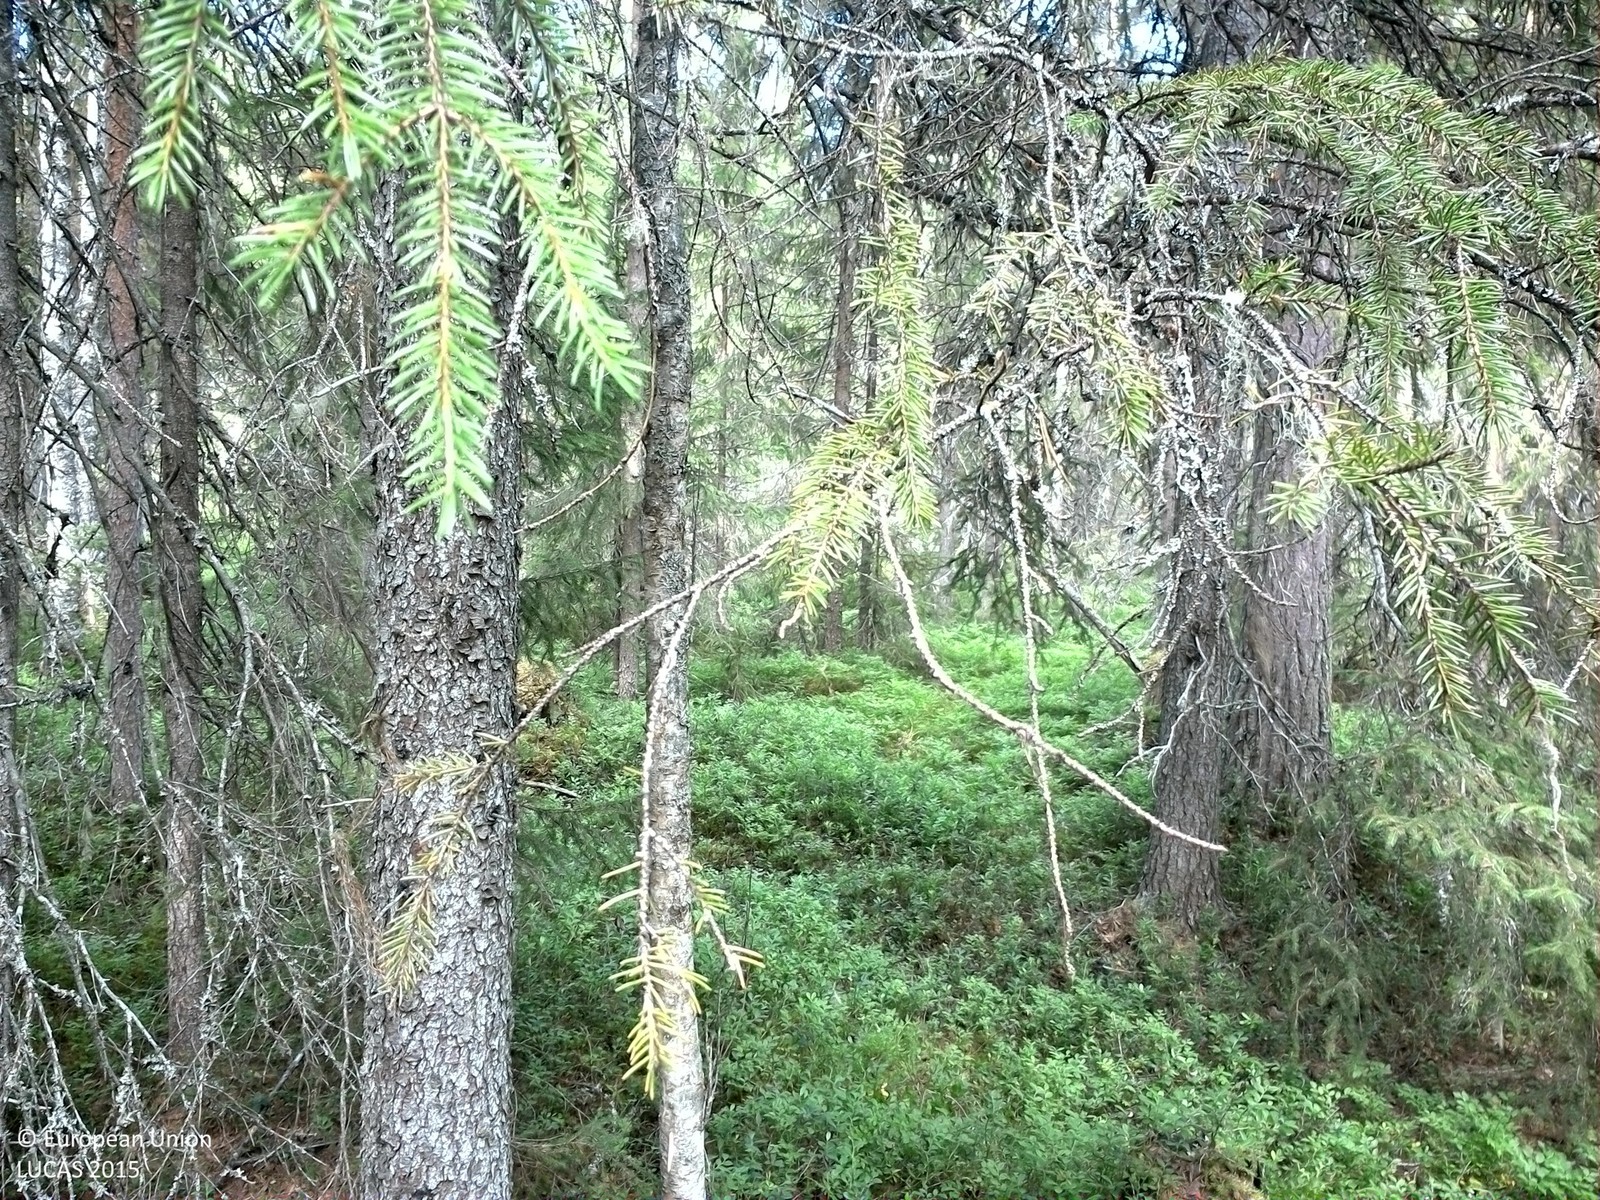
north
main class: Woodland
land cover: Spruce dominated coniferous woodland
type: boreal forest
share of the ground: 50 - 75 %
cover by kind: coniferous forest trees 60 %, shrubs 25 %, lichens and mosses 10 %, broadleaved forest trees 5 %
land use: Forestry
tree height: > 5 m
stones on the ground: < 10 %
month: August
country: SE
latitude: 63.7483
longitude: 16.7201
